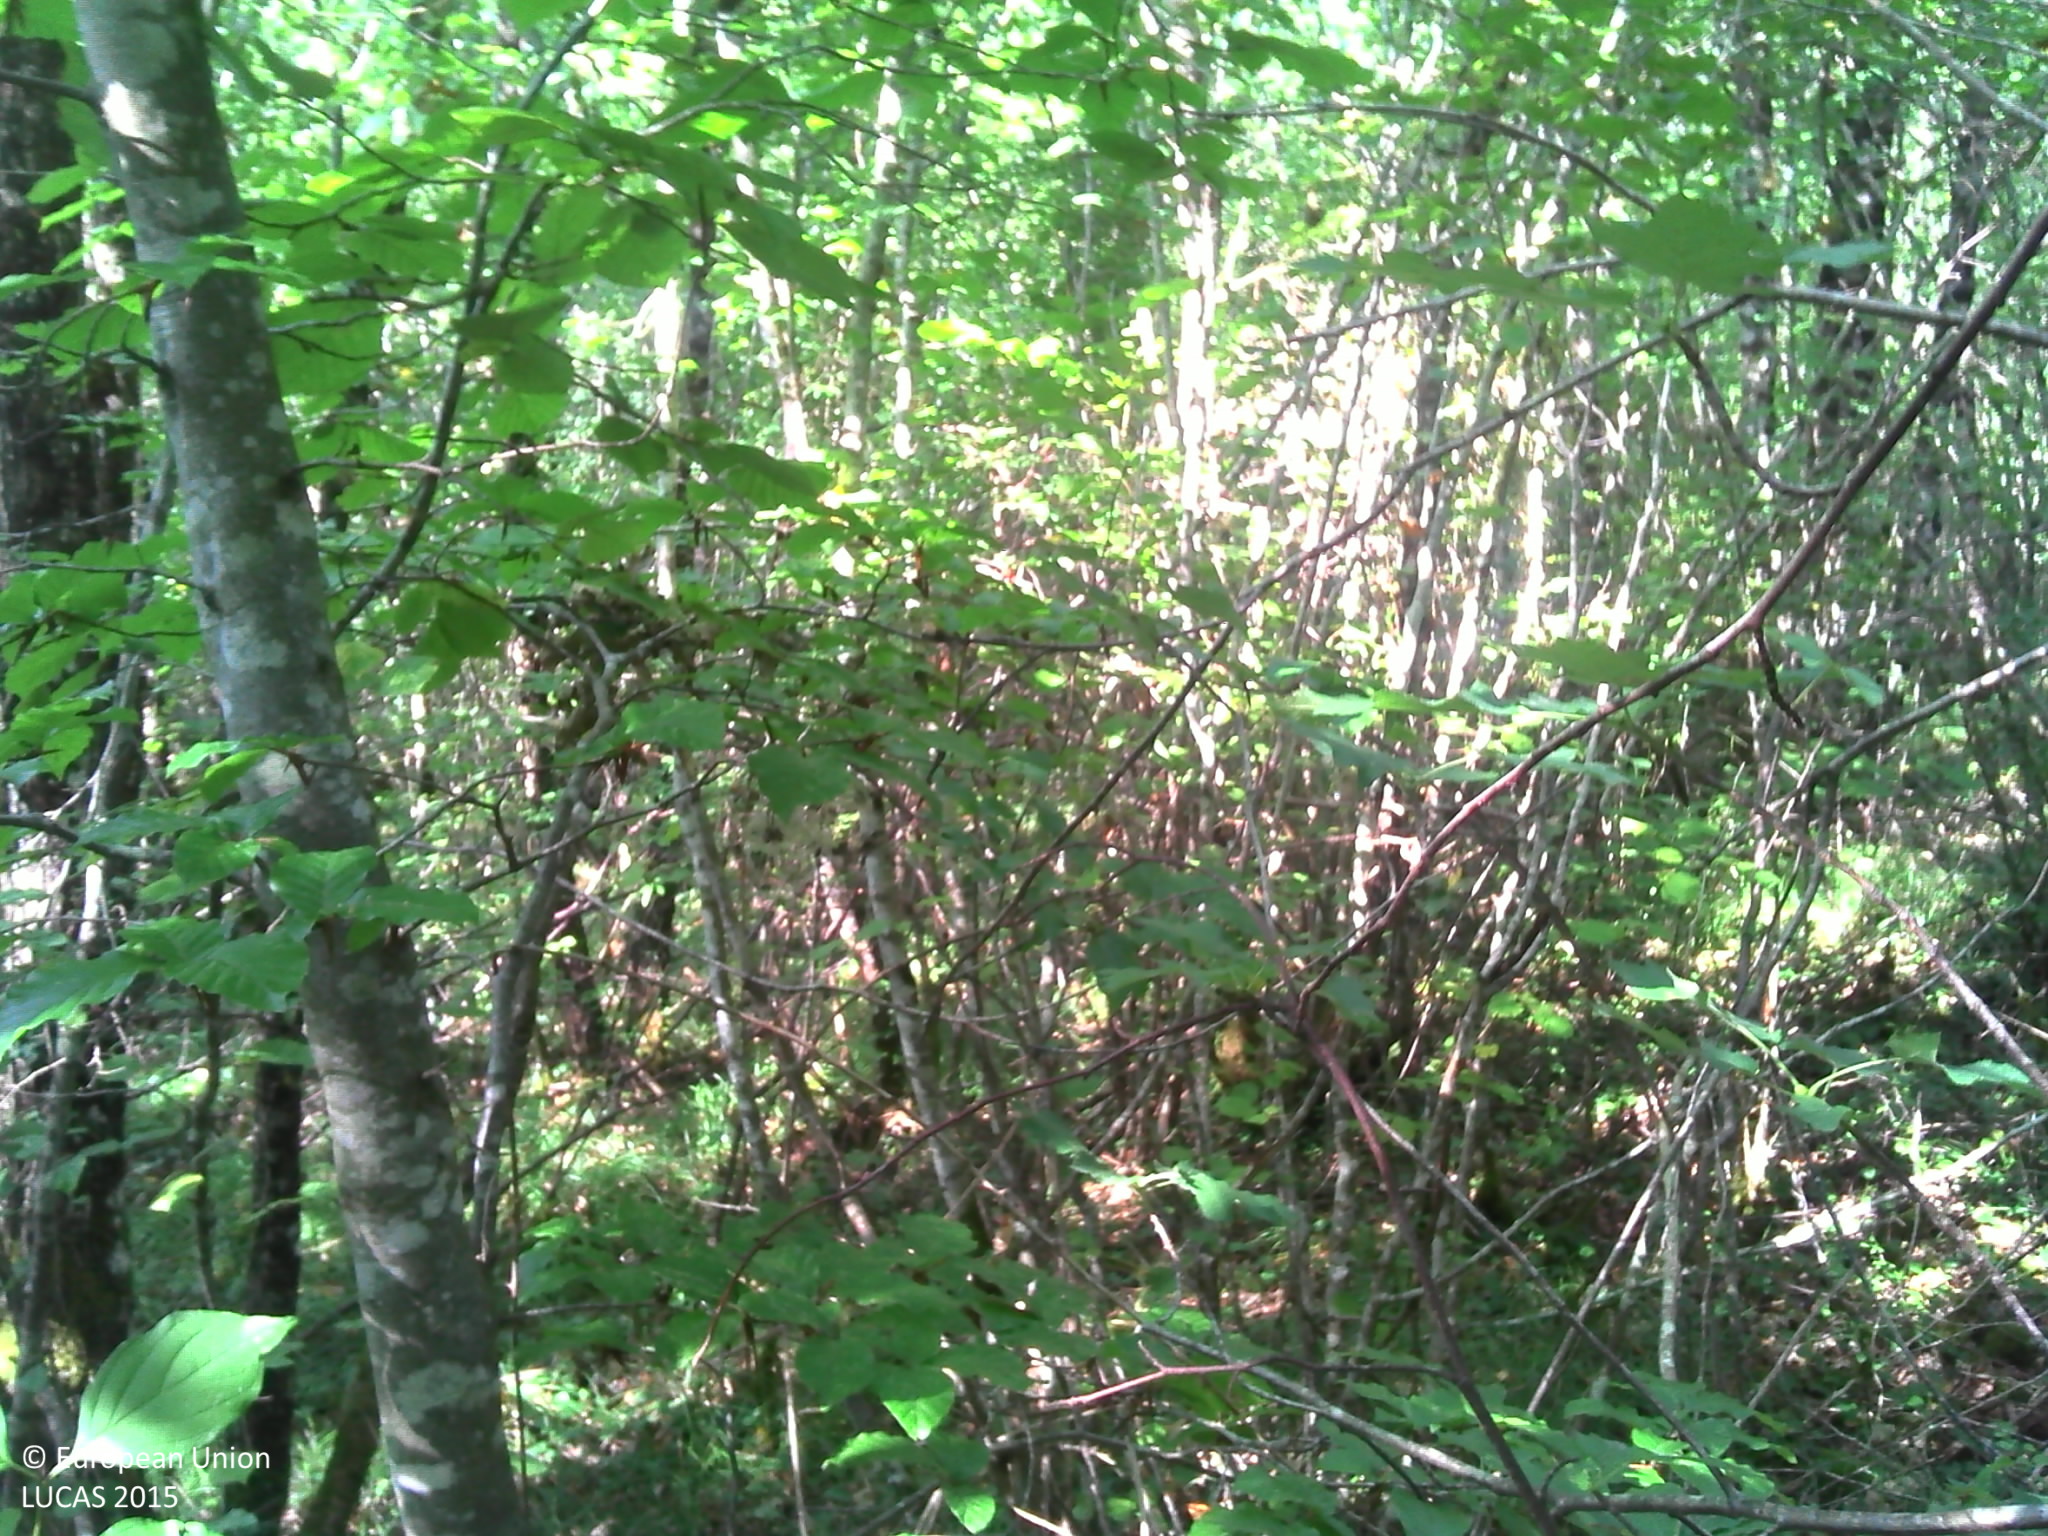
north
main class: Woodland
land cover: Broadleaved woodland
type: mesophytic deciduous forest
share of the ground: > 75 %
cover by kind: broadleaved forest trees 100 %
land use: Semi-natural and natural areas not in use
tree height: > 5 m
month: September
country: FR
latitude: 47.0737
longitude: 1.4139
